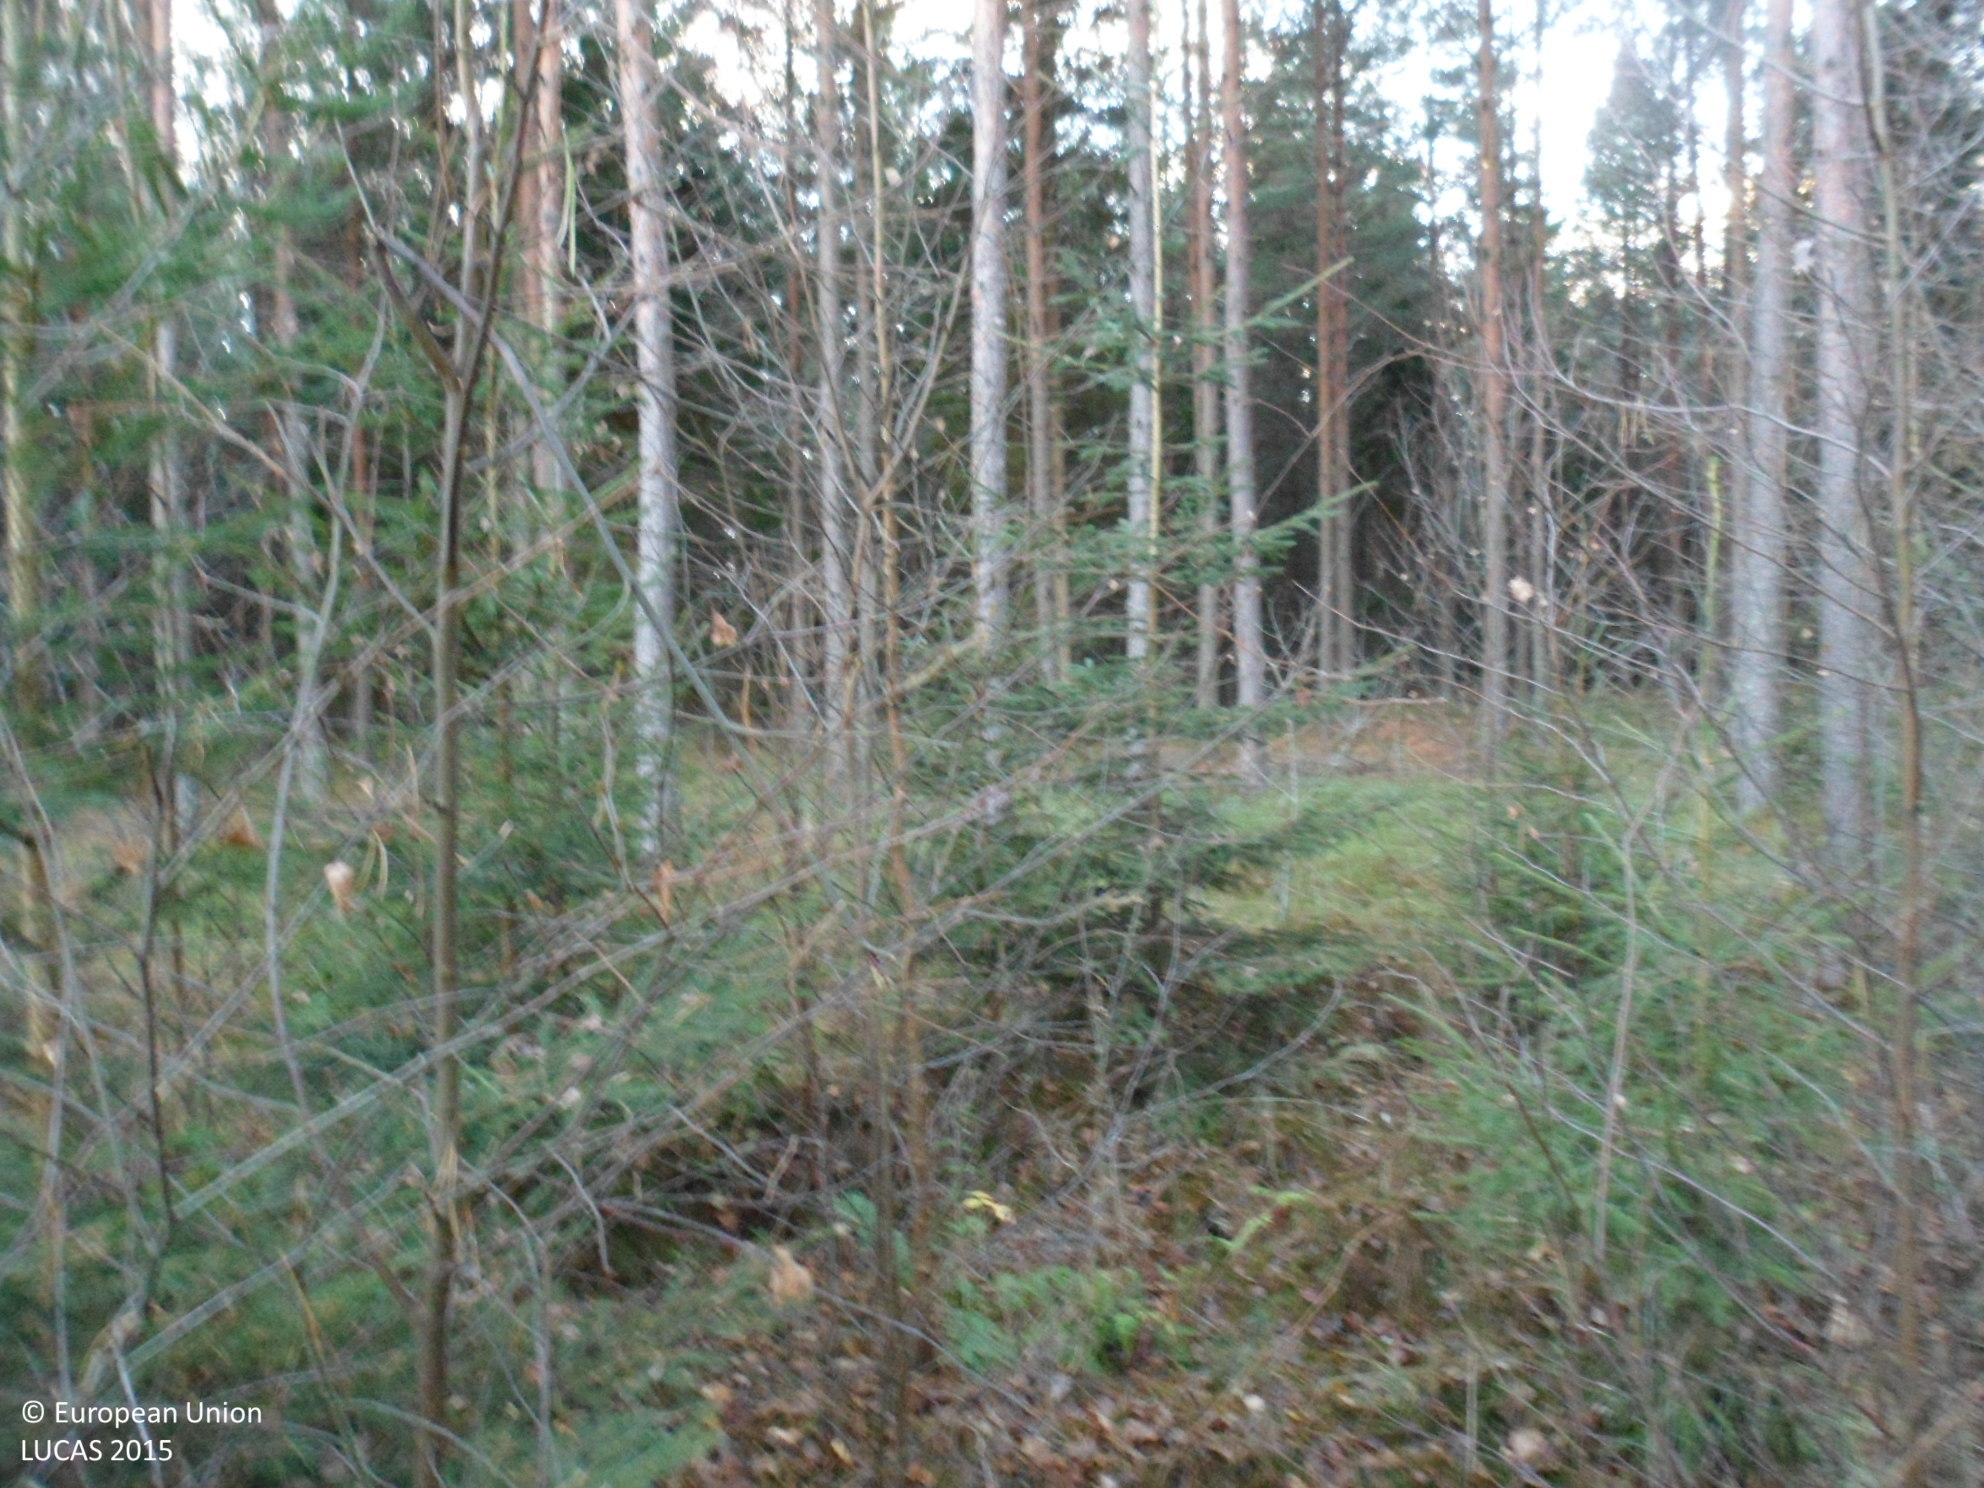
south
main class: Woodland
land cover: Spruce dominated mixed woodland
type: boreal forest
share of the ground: 50 - 75 %
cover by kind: coniferous forest trees 30 %, broadleaved forest trees 30 %, herbaceous plants 15 %, shrubs 10 %, lichens and mosses 10 %, unconsolidated bare surface 5 %
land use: Forestry
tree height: < 5 m
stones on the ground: 25 - 50 %
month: November
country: SE
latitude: 56.7594
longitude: 16.1996
